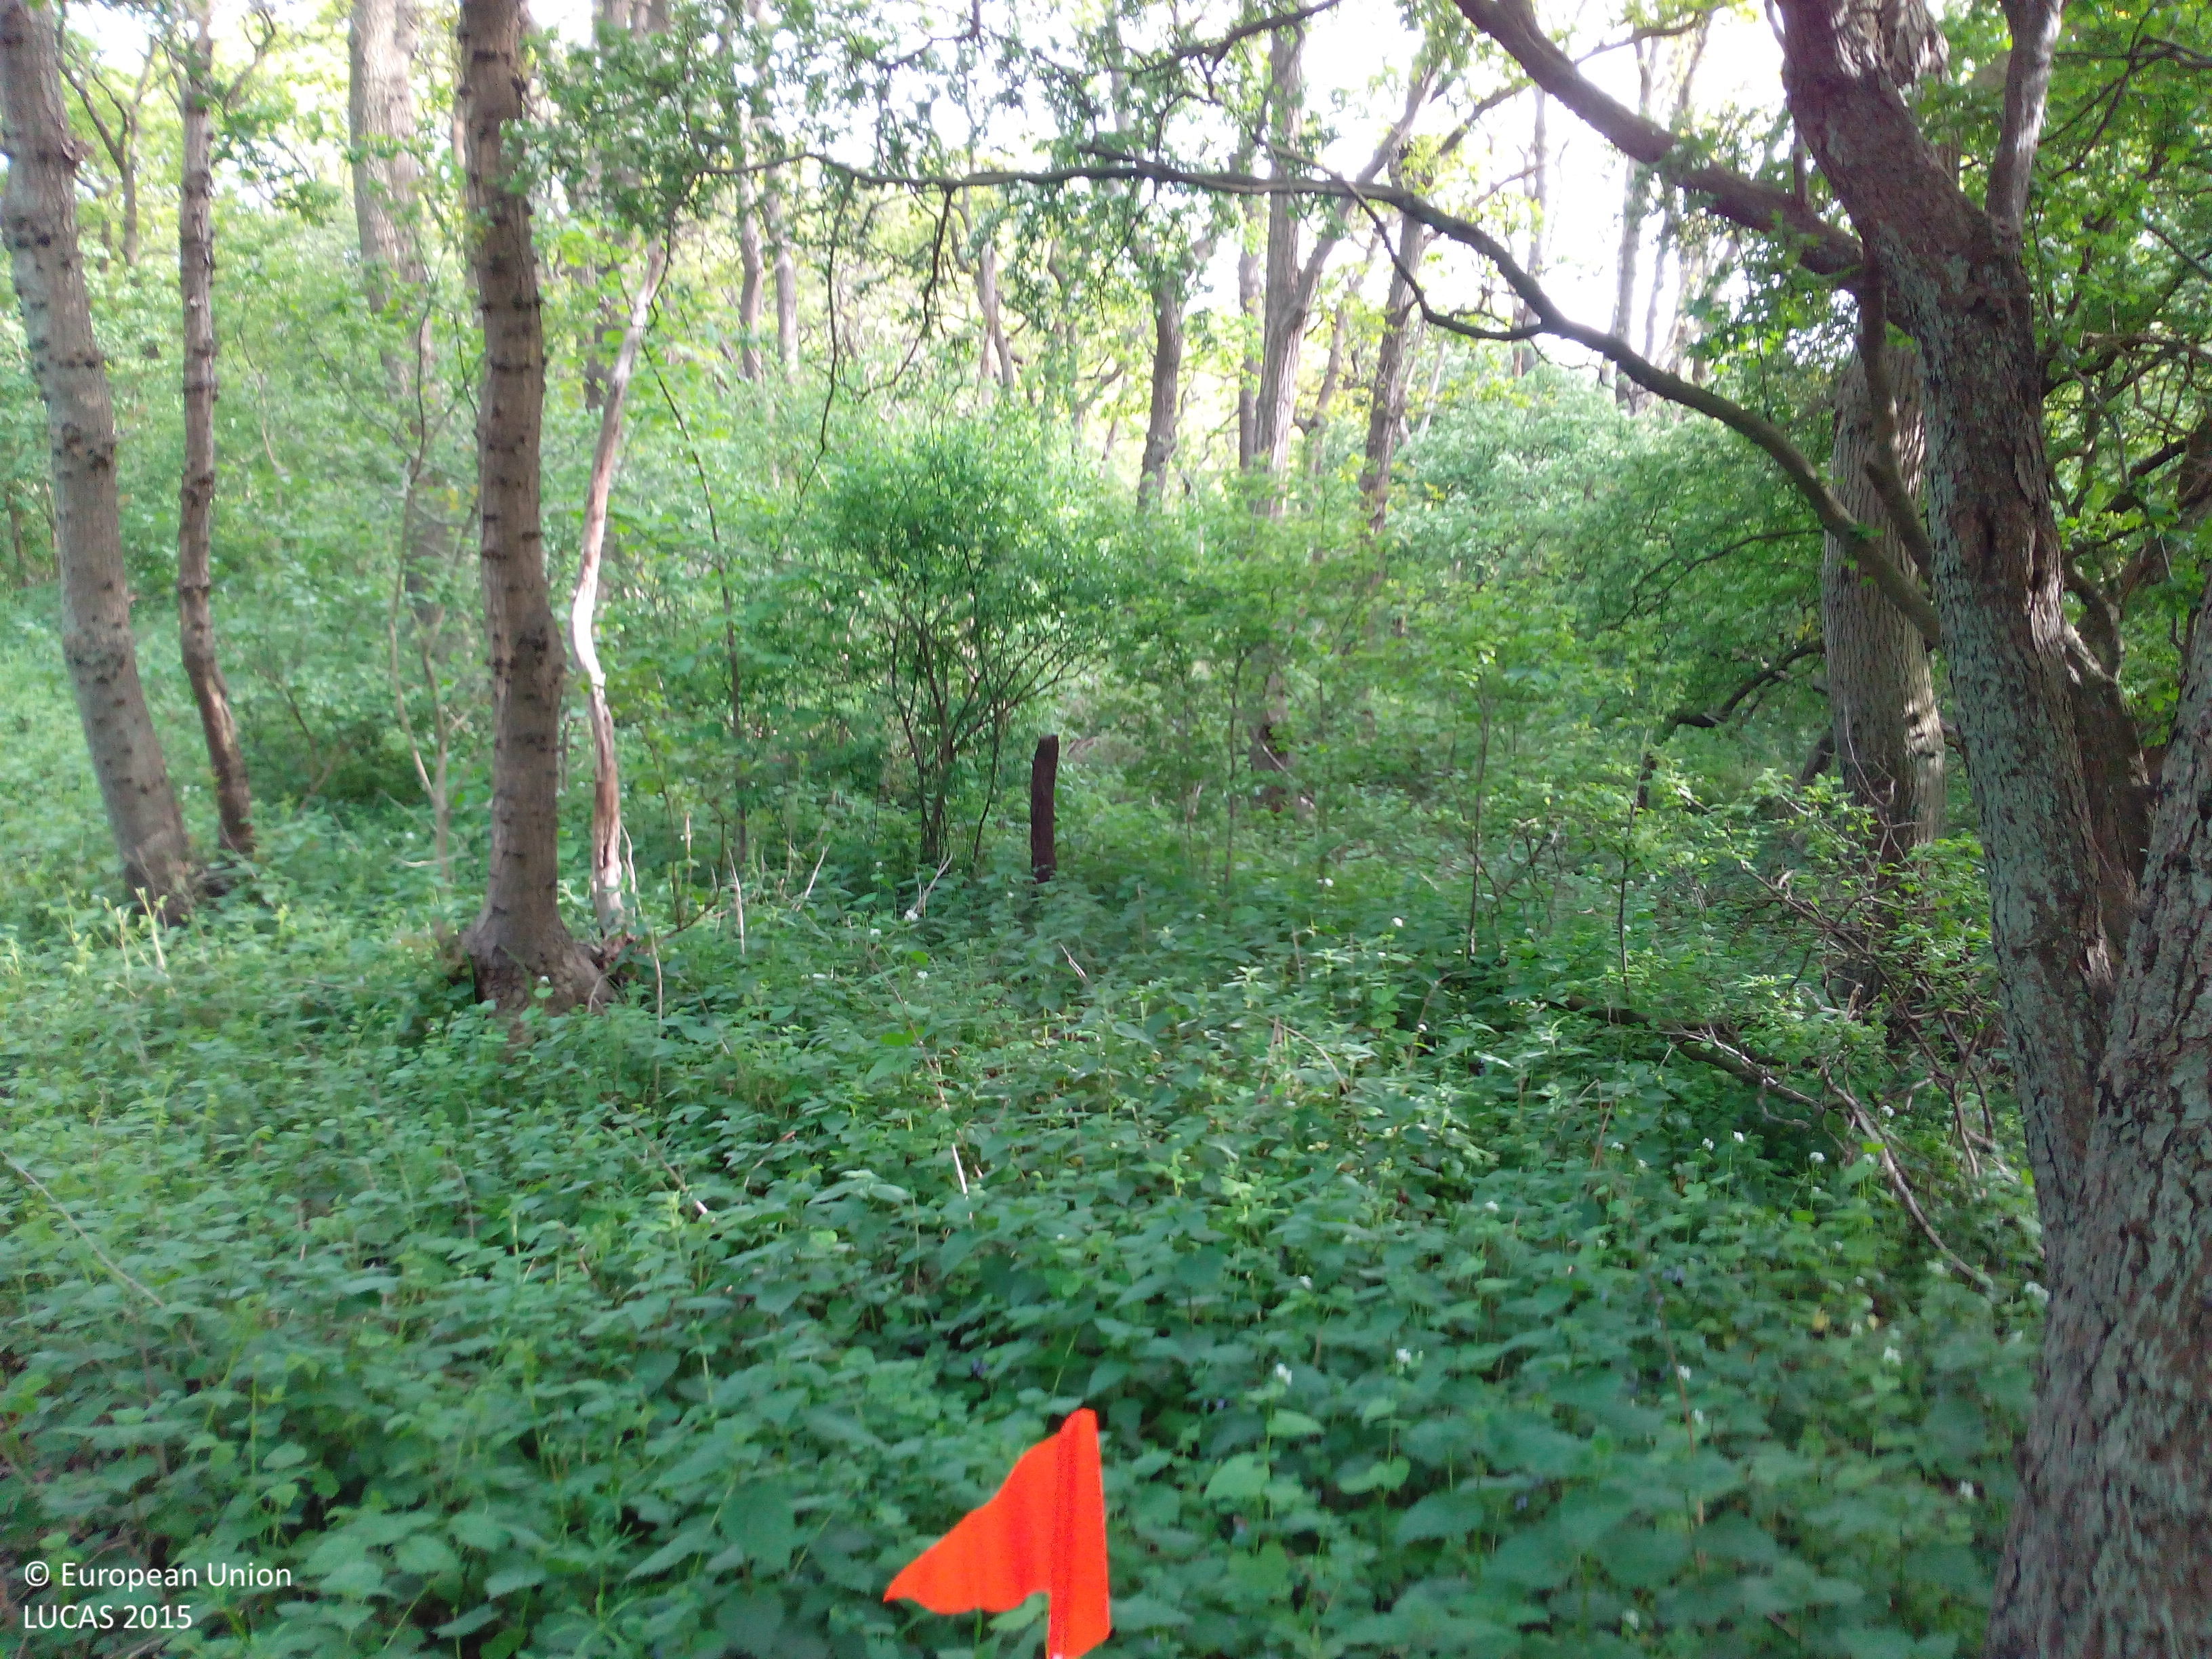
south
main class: Woodland
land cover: Broadleaved woodland
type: acidophilous oak and oak-birch forest
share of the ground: > 75 %
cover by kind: broadleaved forest trees 90 %, shrubs 10 %
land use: Semi-natural and natural areas not in use
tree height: > 5 m
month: May
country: NL
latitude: 52.4898
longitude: 4.6209
